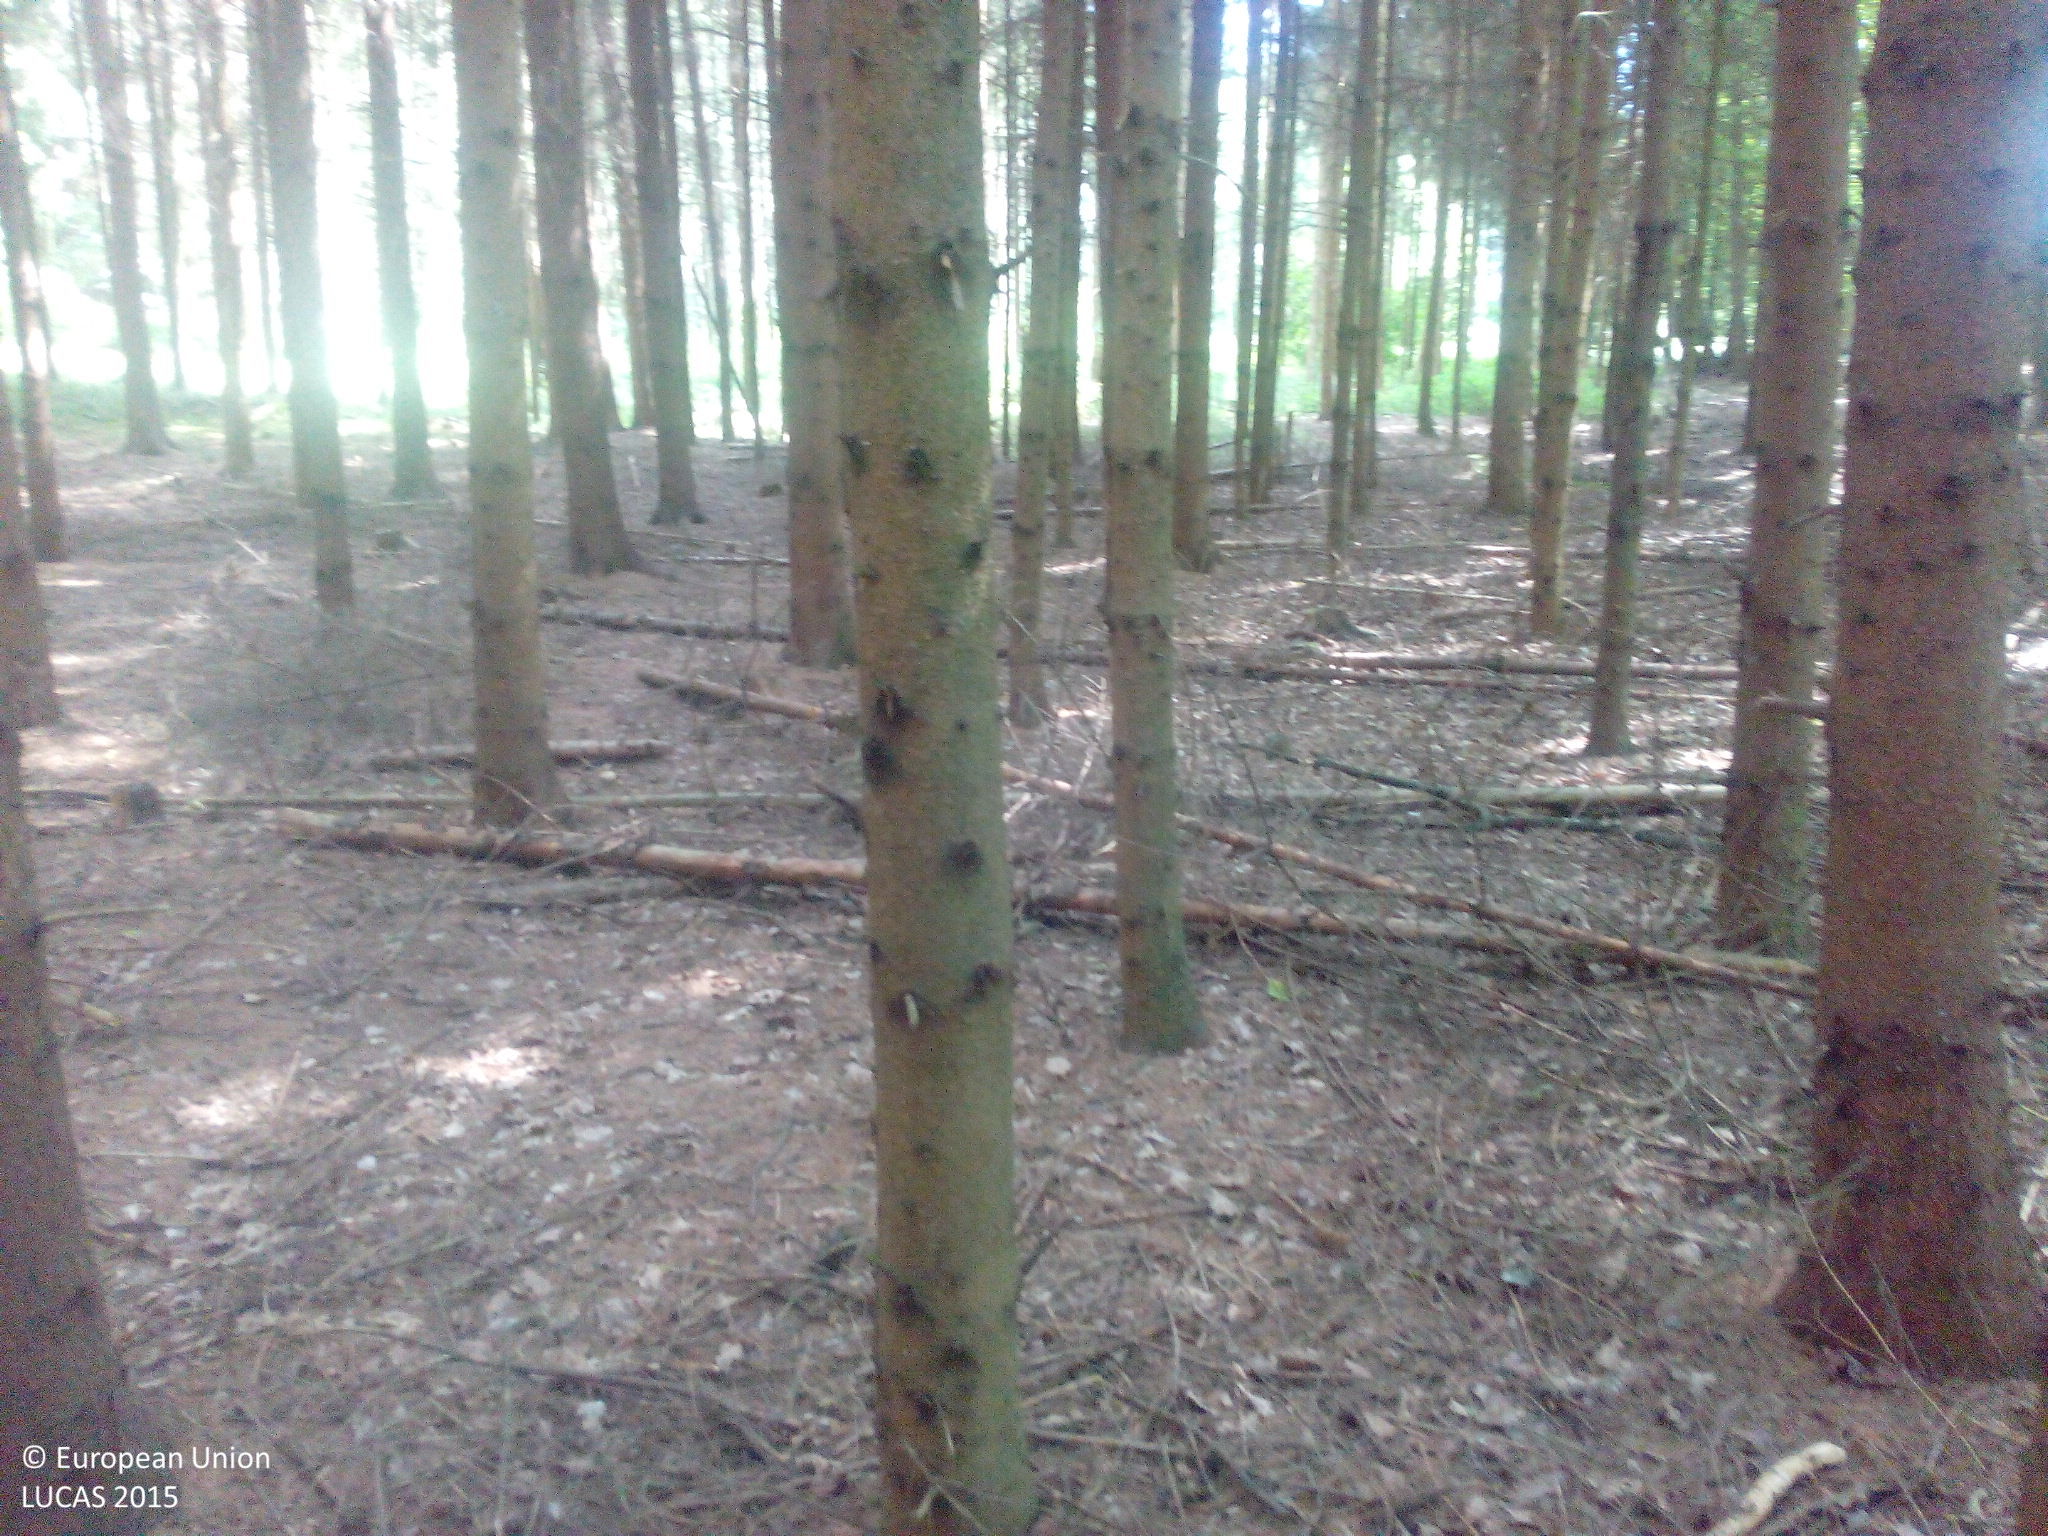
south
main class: Woodland
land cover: Spruce dominated coniferous woodland
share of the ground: > 75 %
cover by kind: coniferous forest trees 95 %, unconsolidated bare surface 5 %
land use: Forestry
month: July
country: DE
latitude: 49.7670
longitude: 10.9022
